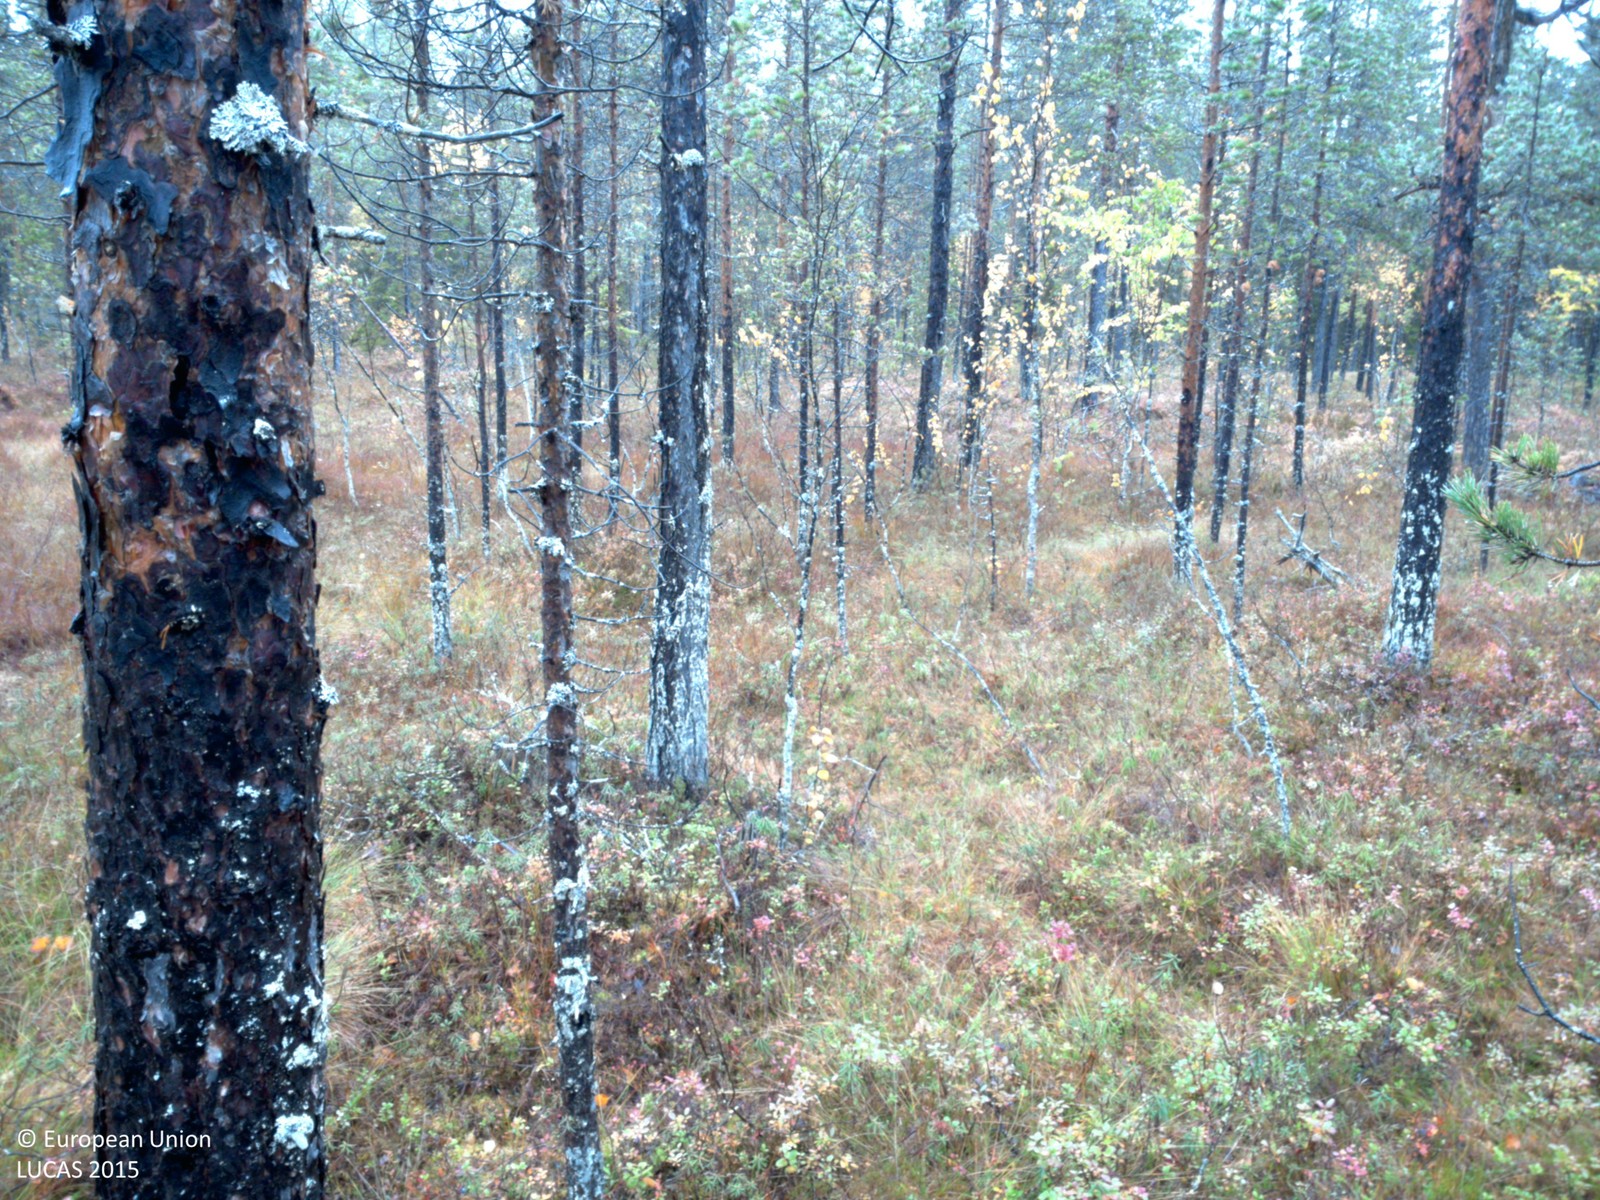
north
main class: Woodland
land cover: Pine dominated coniferous woodland
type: mire and swamp forests
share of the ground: 25 - 50 %
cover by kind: shrubs 35 %, coniferous forest trees 25 %, herbaceous plants 20 %, lichens and mosses 15 %, broadleaved forest trees 5 %
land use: Forestry
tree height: > 5 m
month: September
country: SE
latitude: 64.9718
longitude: 19.1389
